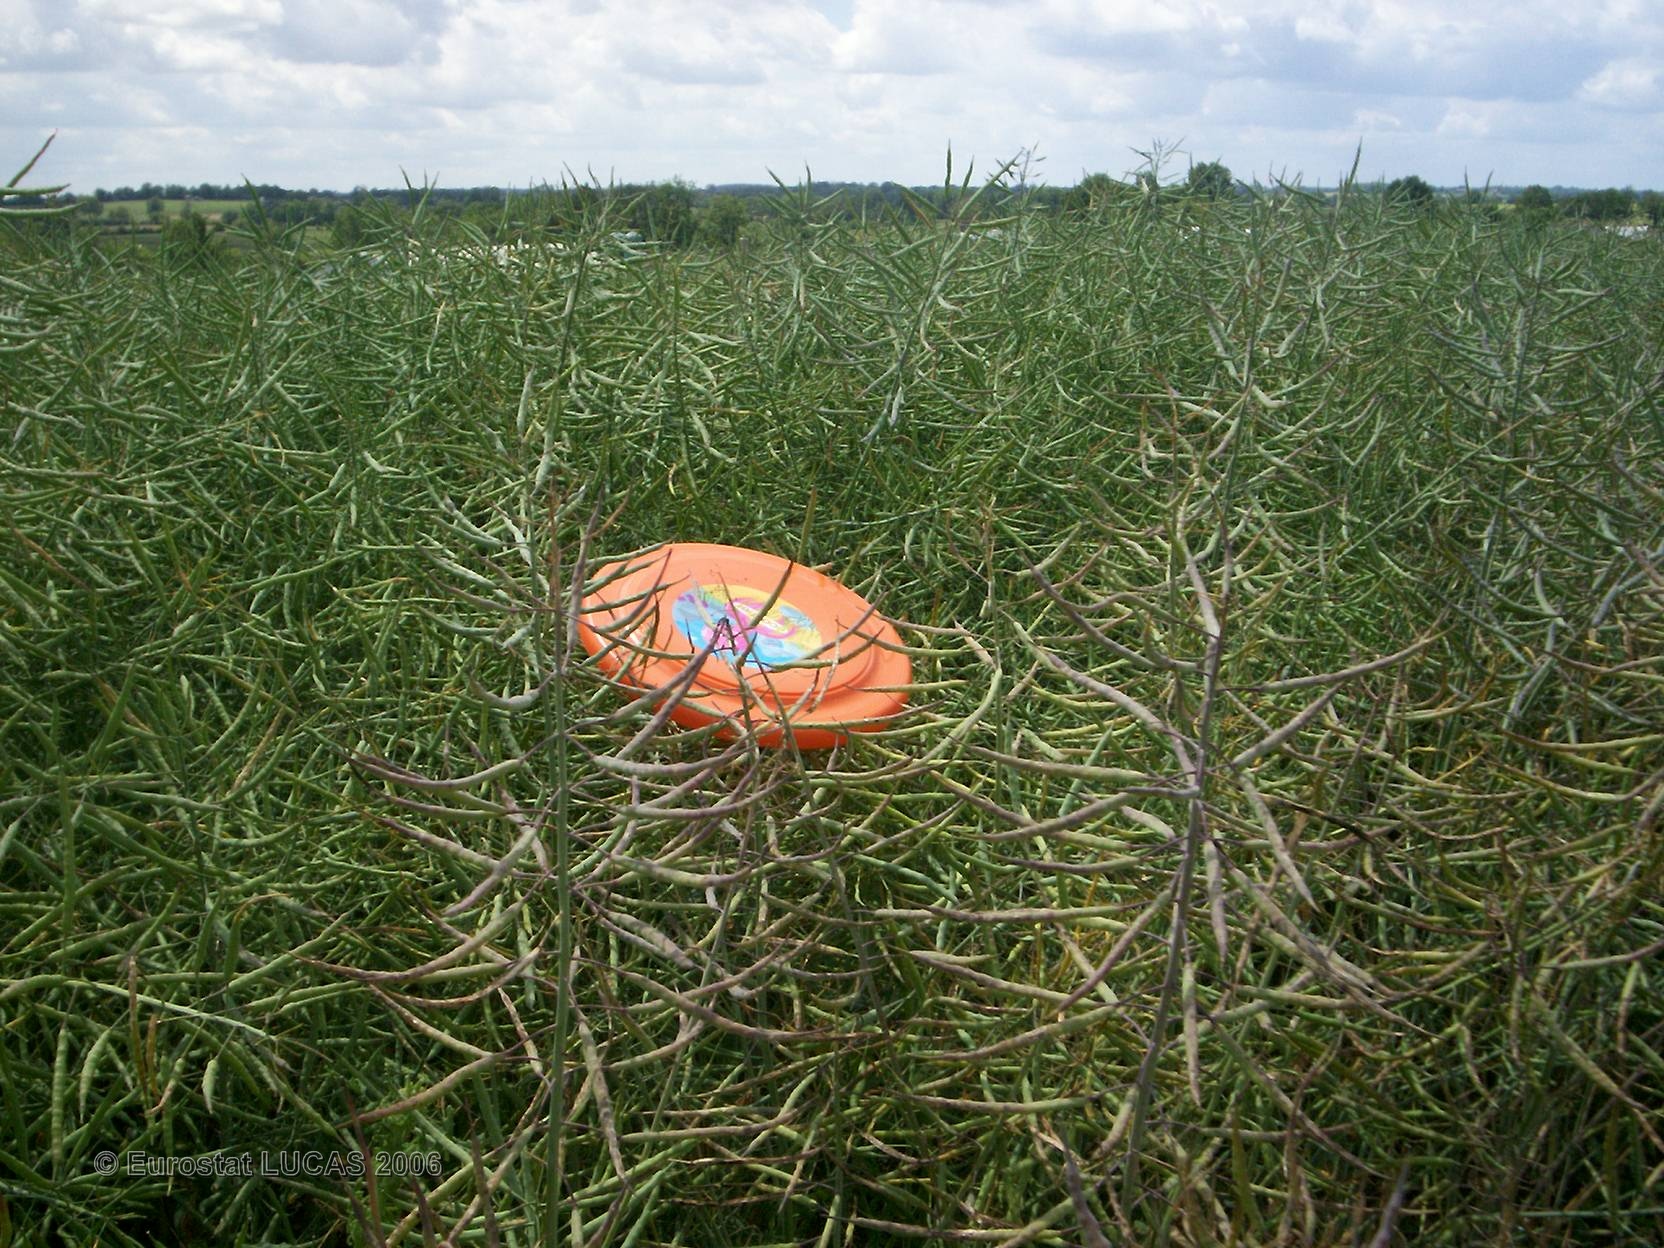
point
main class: Cropland
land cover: Rape and turnip rape
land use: Agriculture (excluding fallow land and kitchen gardens)
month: May
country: FR
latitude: 47.5842
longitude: -1.1412
